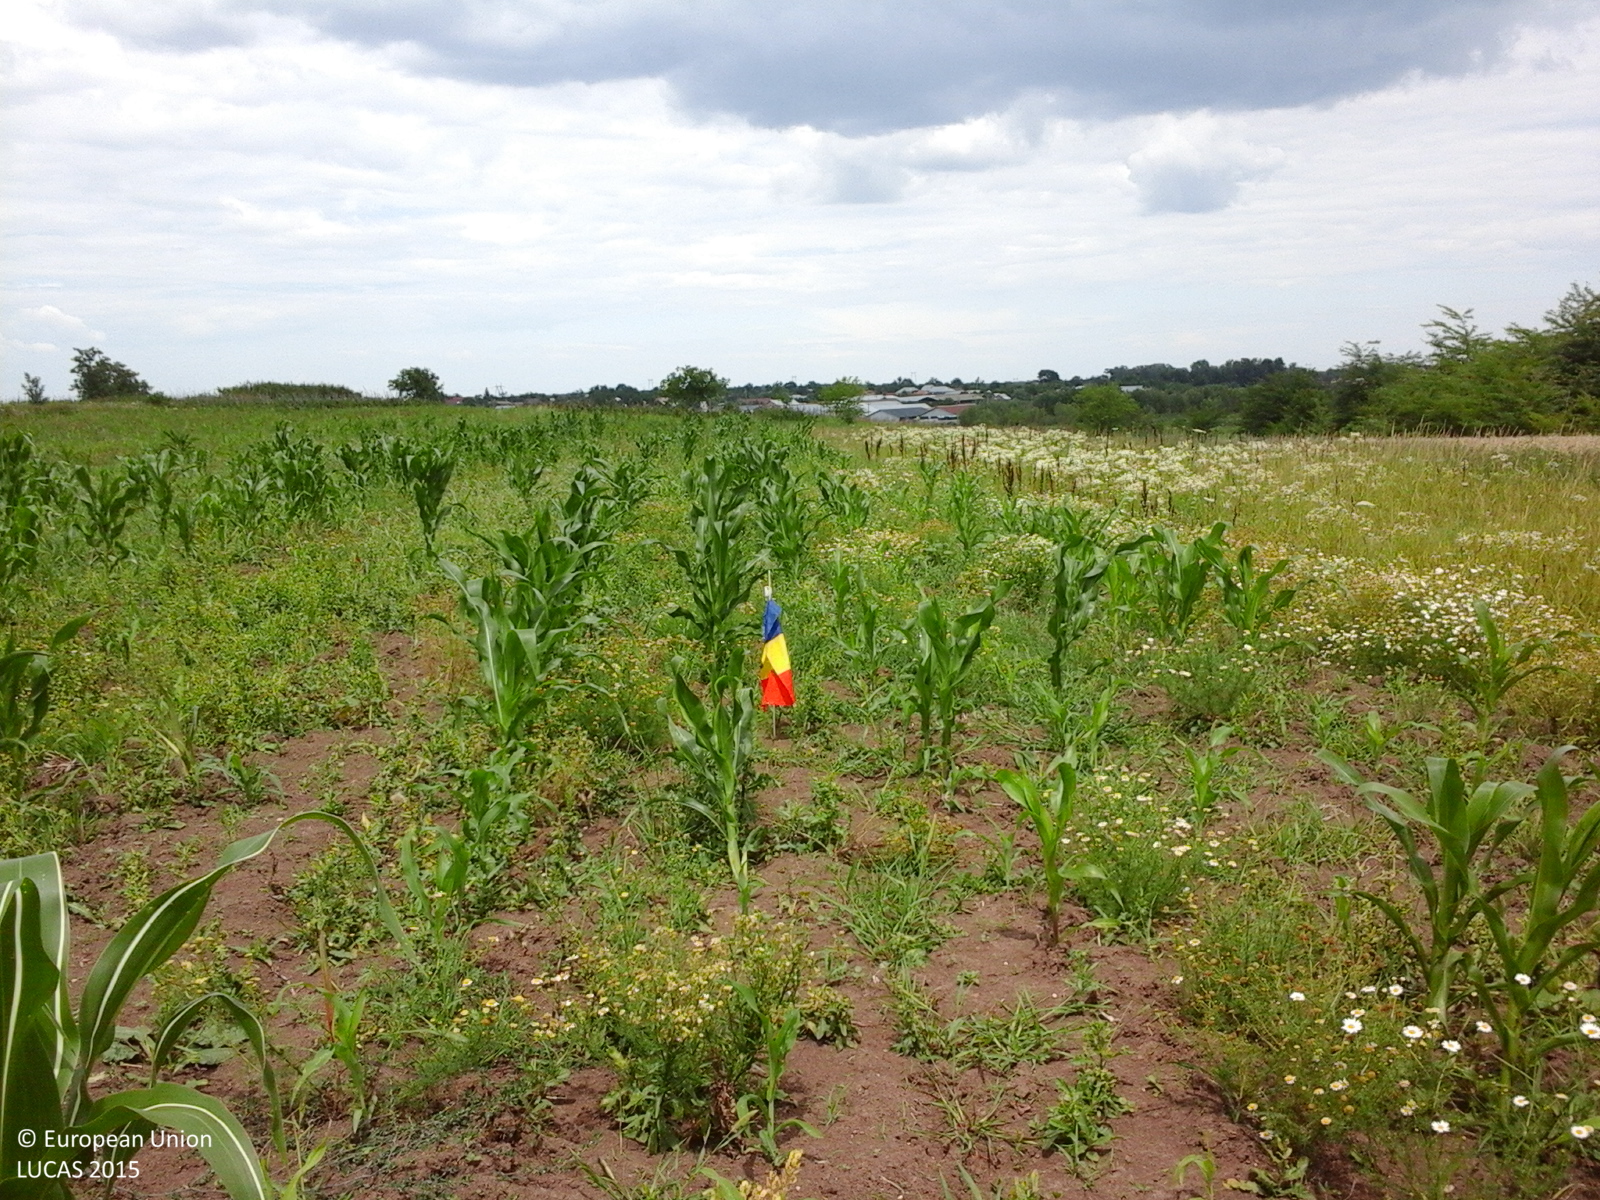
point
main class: Cropland
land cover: Maize
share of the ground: 25 - 50 %
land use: Agriculture (excluding fallow land and kitchen gardens)
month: July
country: RO
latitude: 44.3001
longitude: 24.7262
